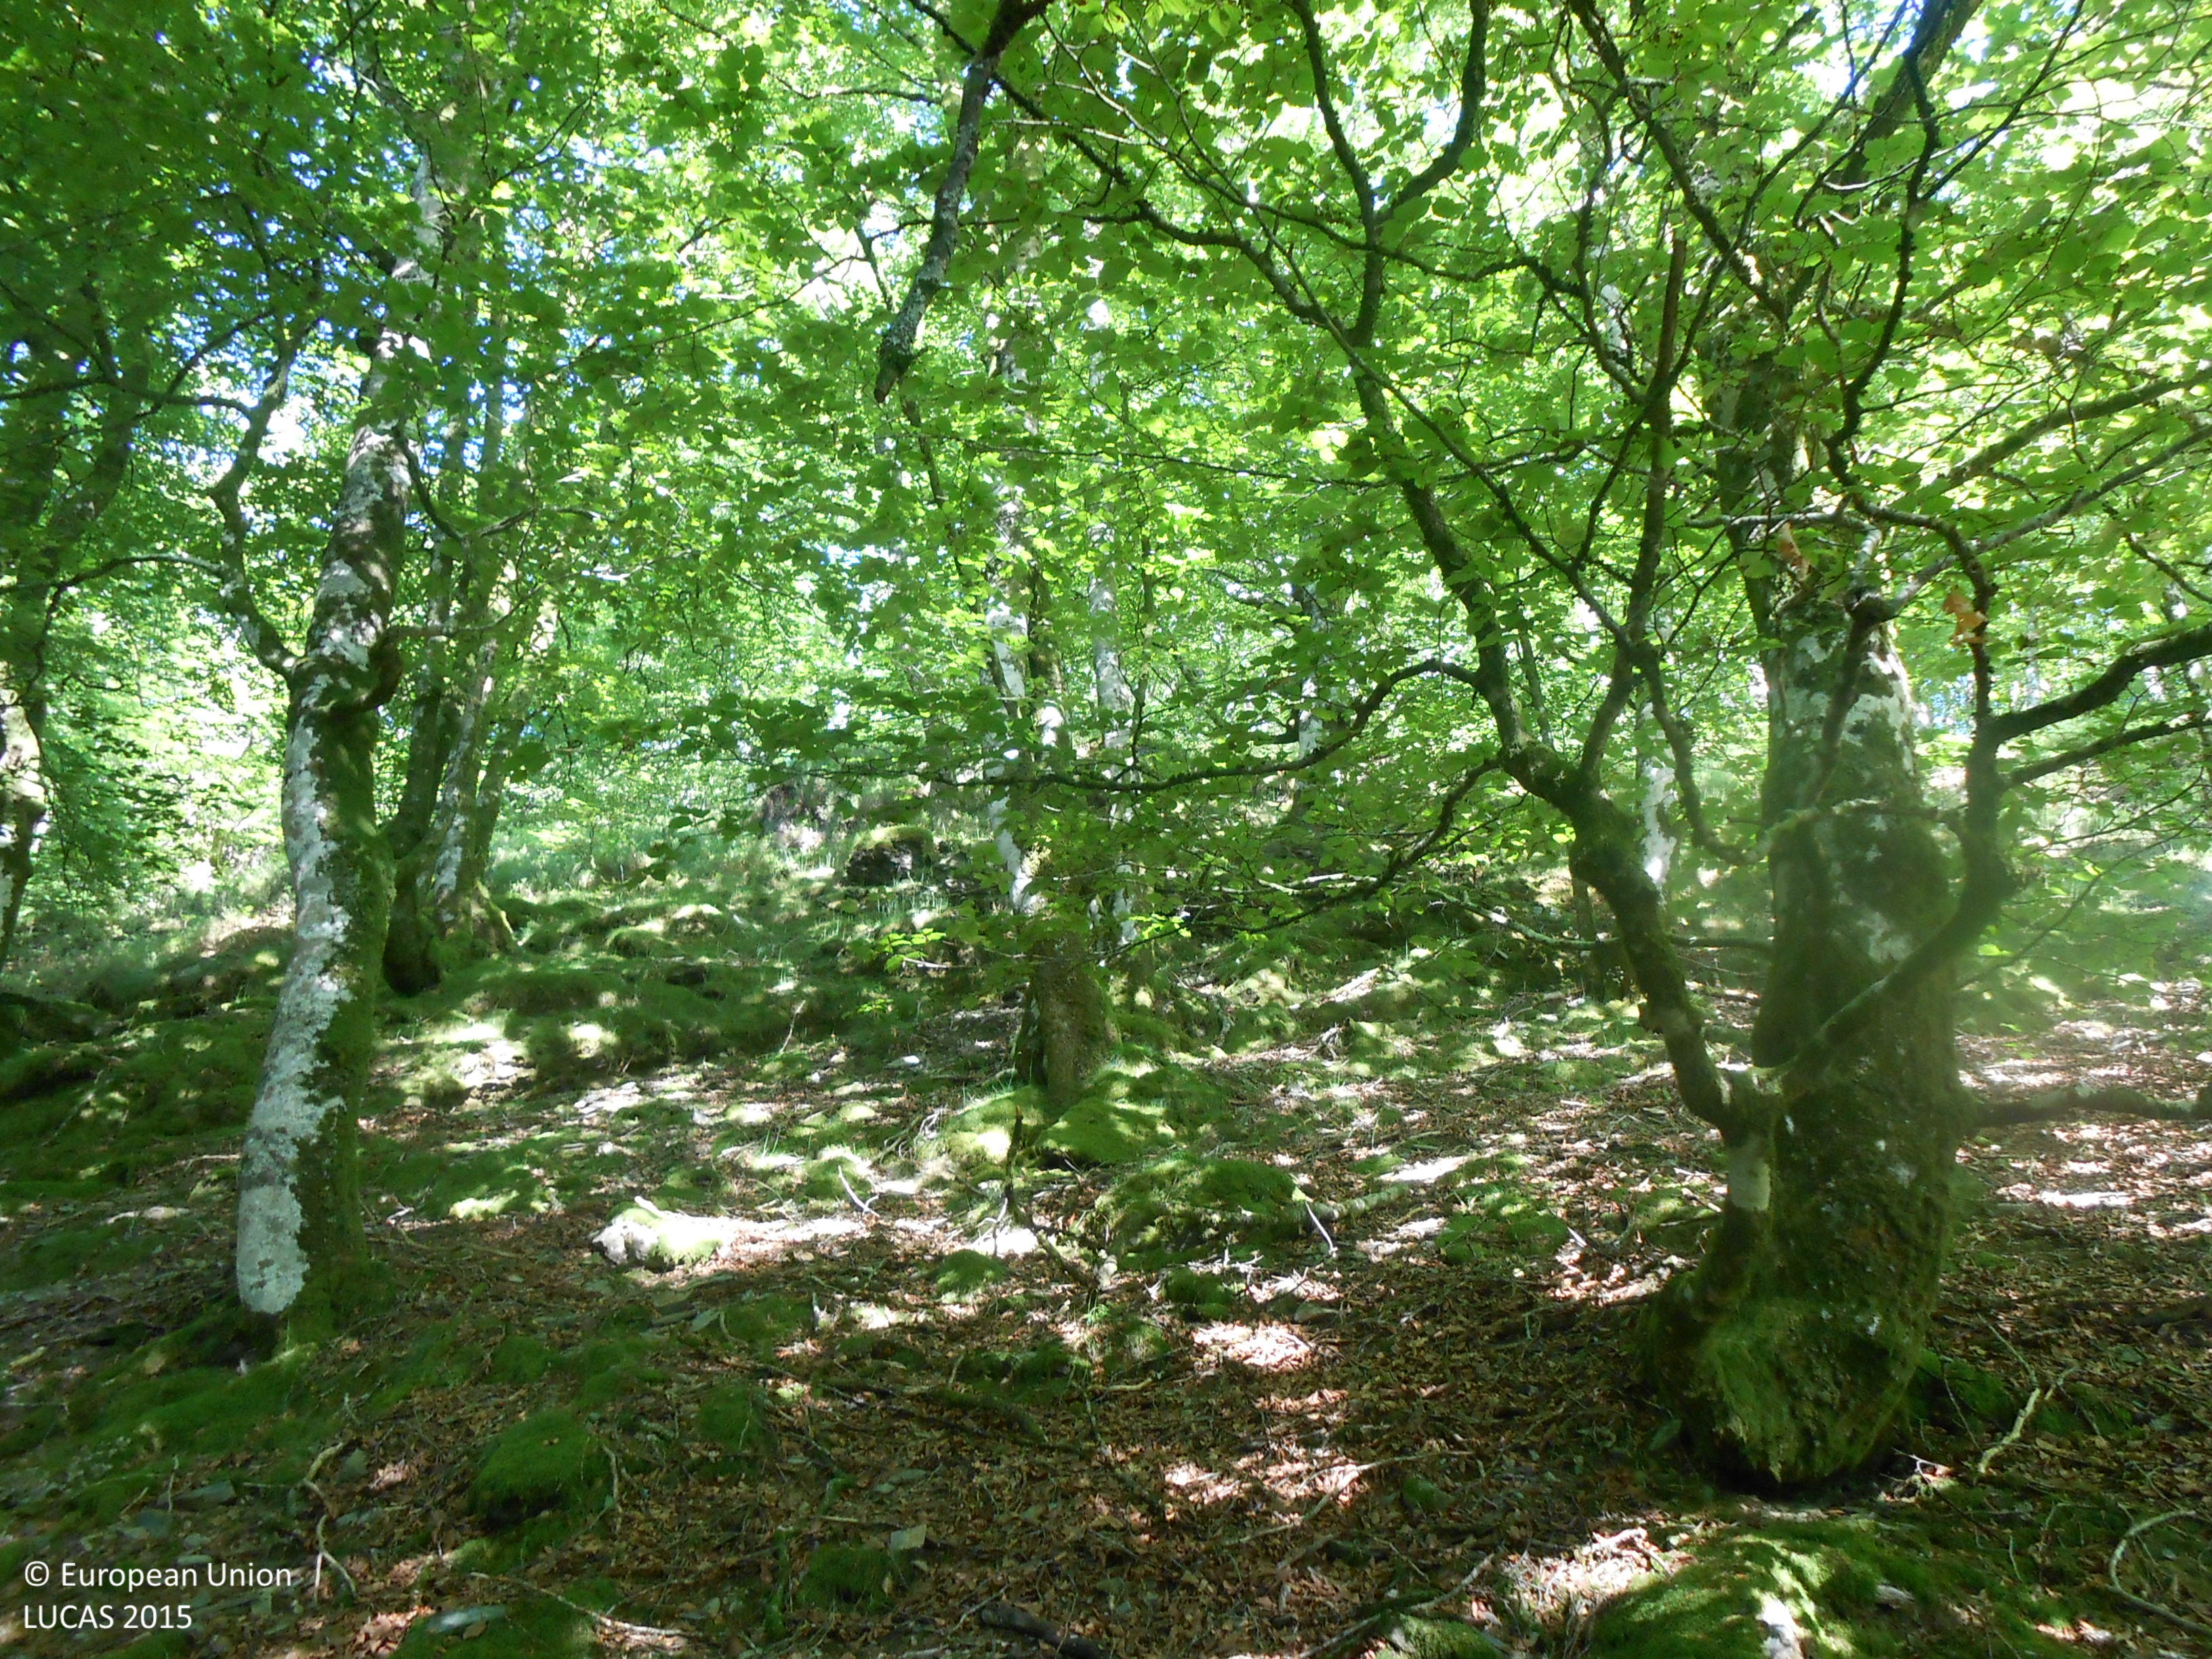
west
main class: Woodland
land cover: Broadleaved woodland
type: beech forest
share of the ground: > 75 %
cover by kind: broadleaved forest trees 100 %
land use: Forestry
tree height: > 5 m
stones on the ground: 25 - 50 %
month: June
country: ES
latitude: 43.1125
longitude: -1.7793
